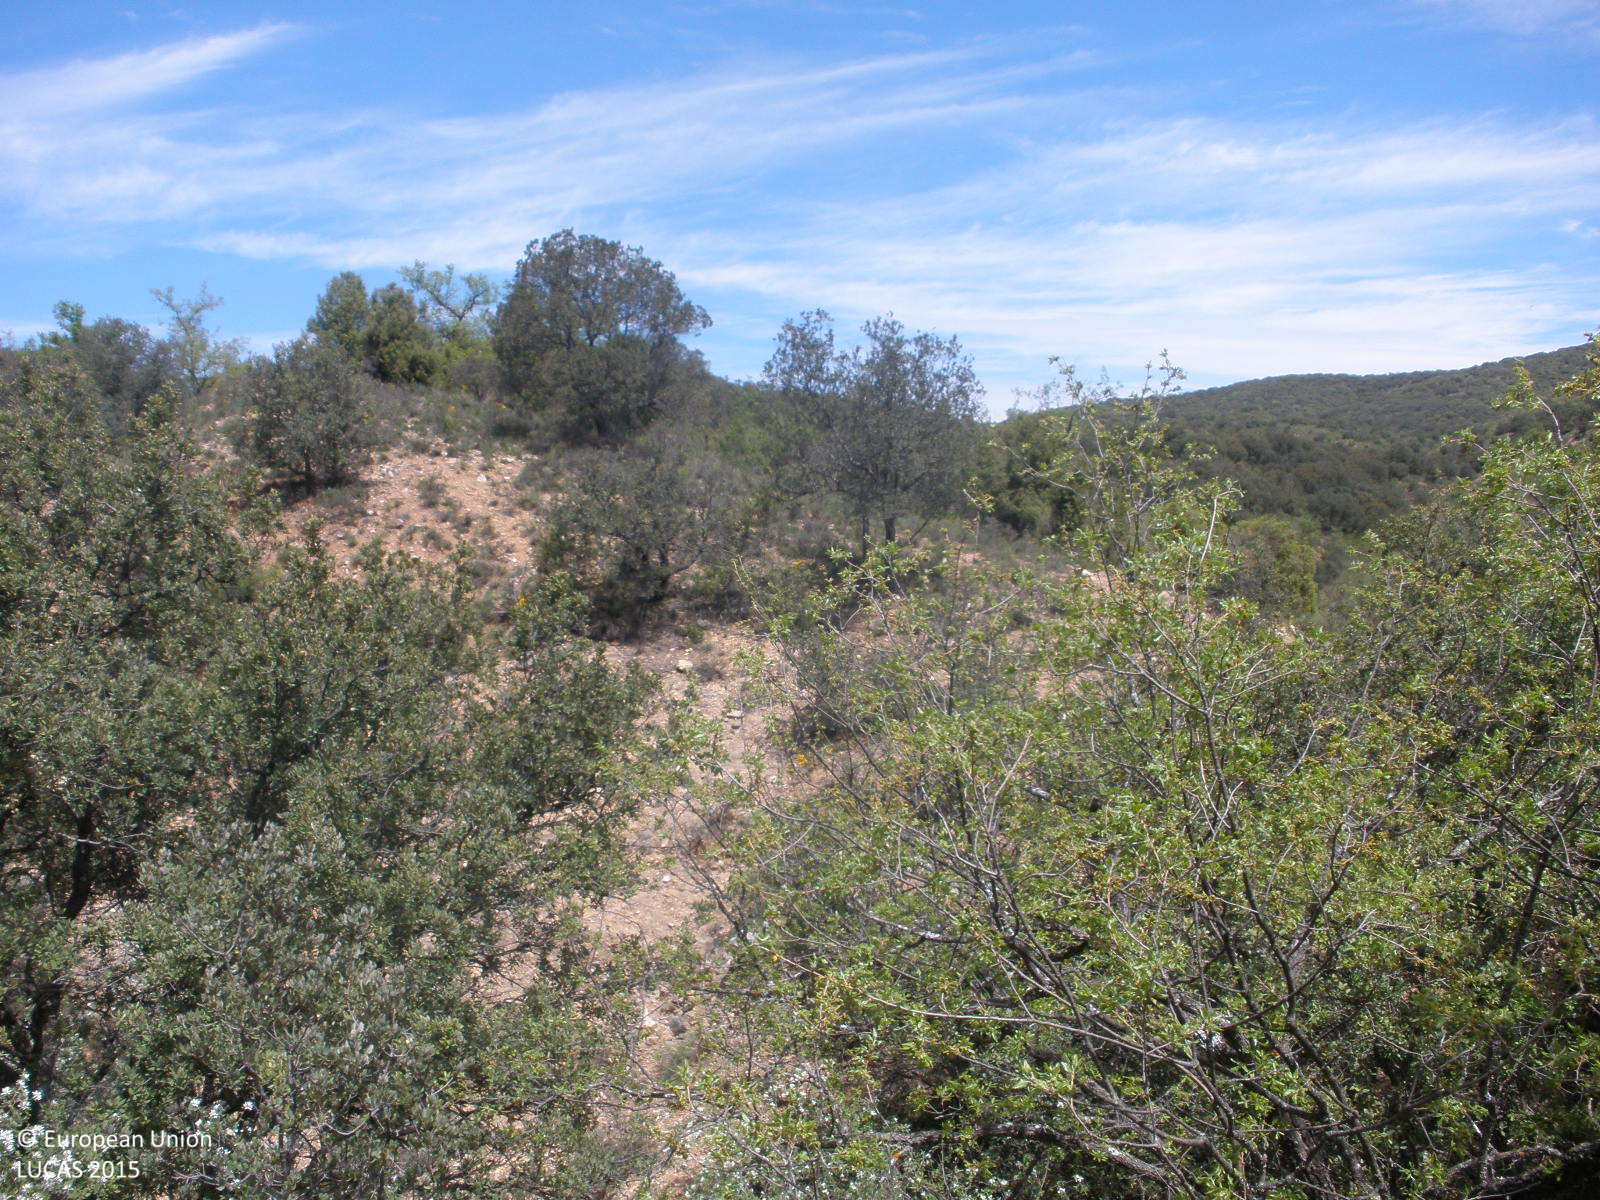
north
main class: Woodland
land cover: Broadleaved woodland
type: broadleaved evergreen forest
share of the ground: > 75 %
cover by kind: broadleaved forest trees 70 %, shrubs 20 %, consolidated bare surface 10 %
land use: Semi-natural and natural areas not in use
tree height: > 5 m
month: May
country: ES
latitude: 40.8777
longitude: -0.9201
